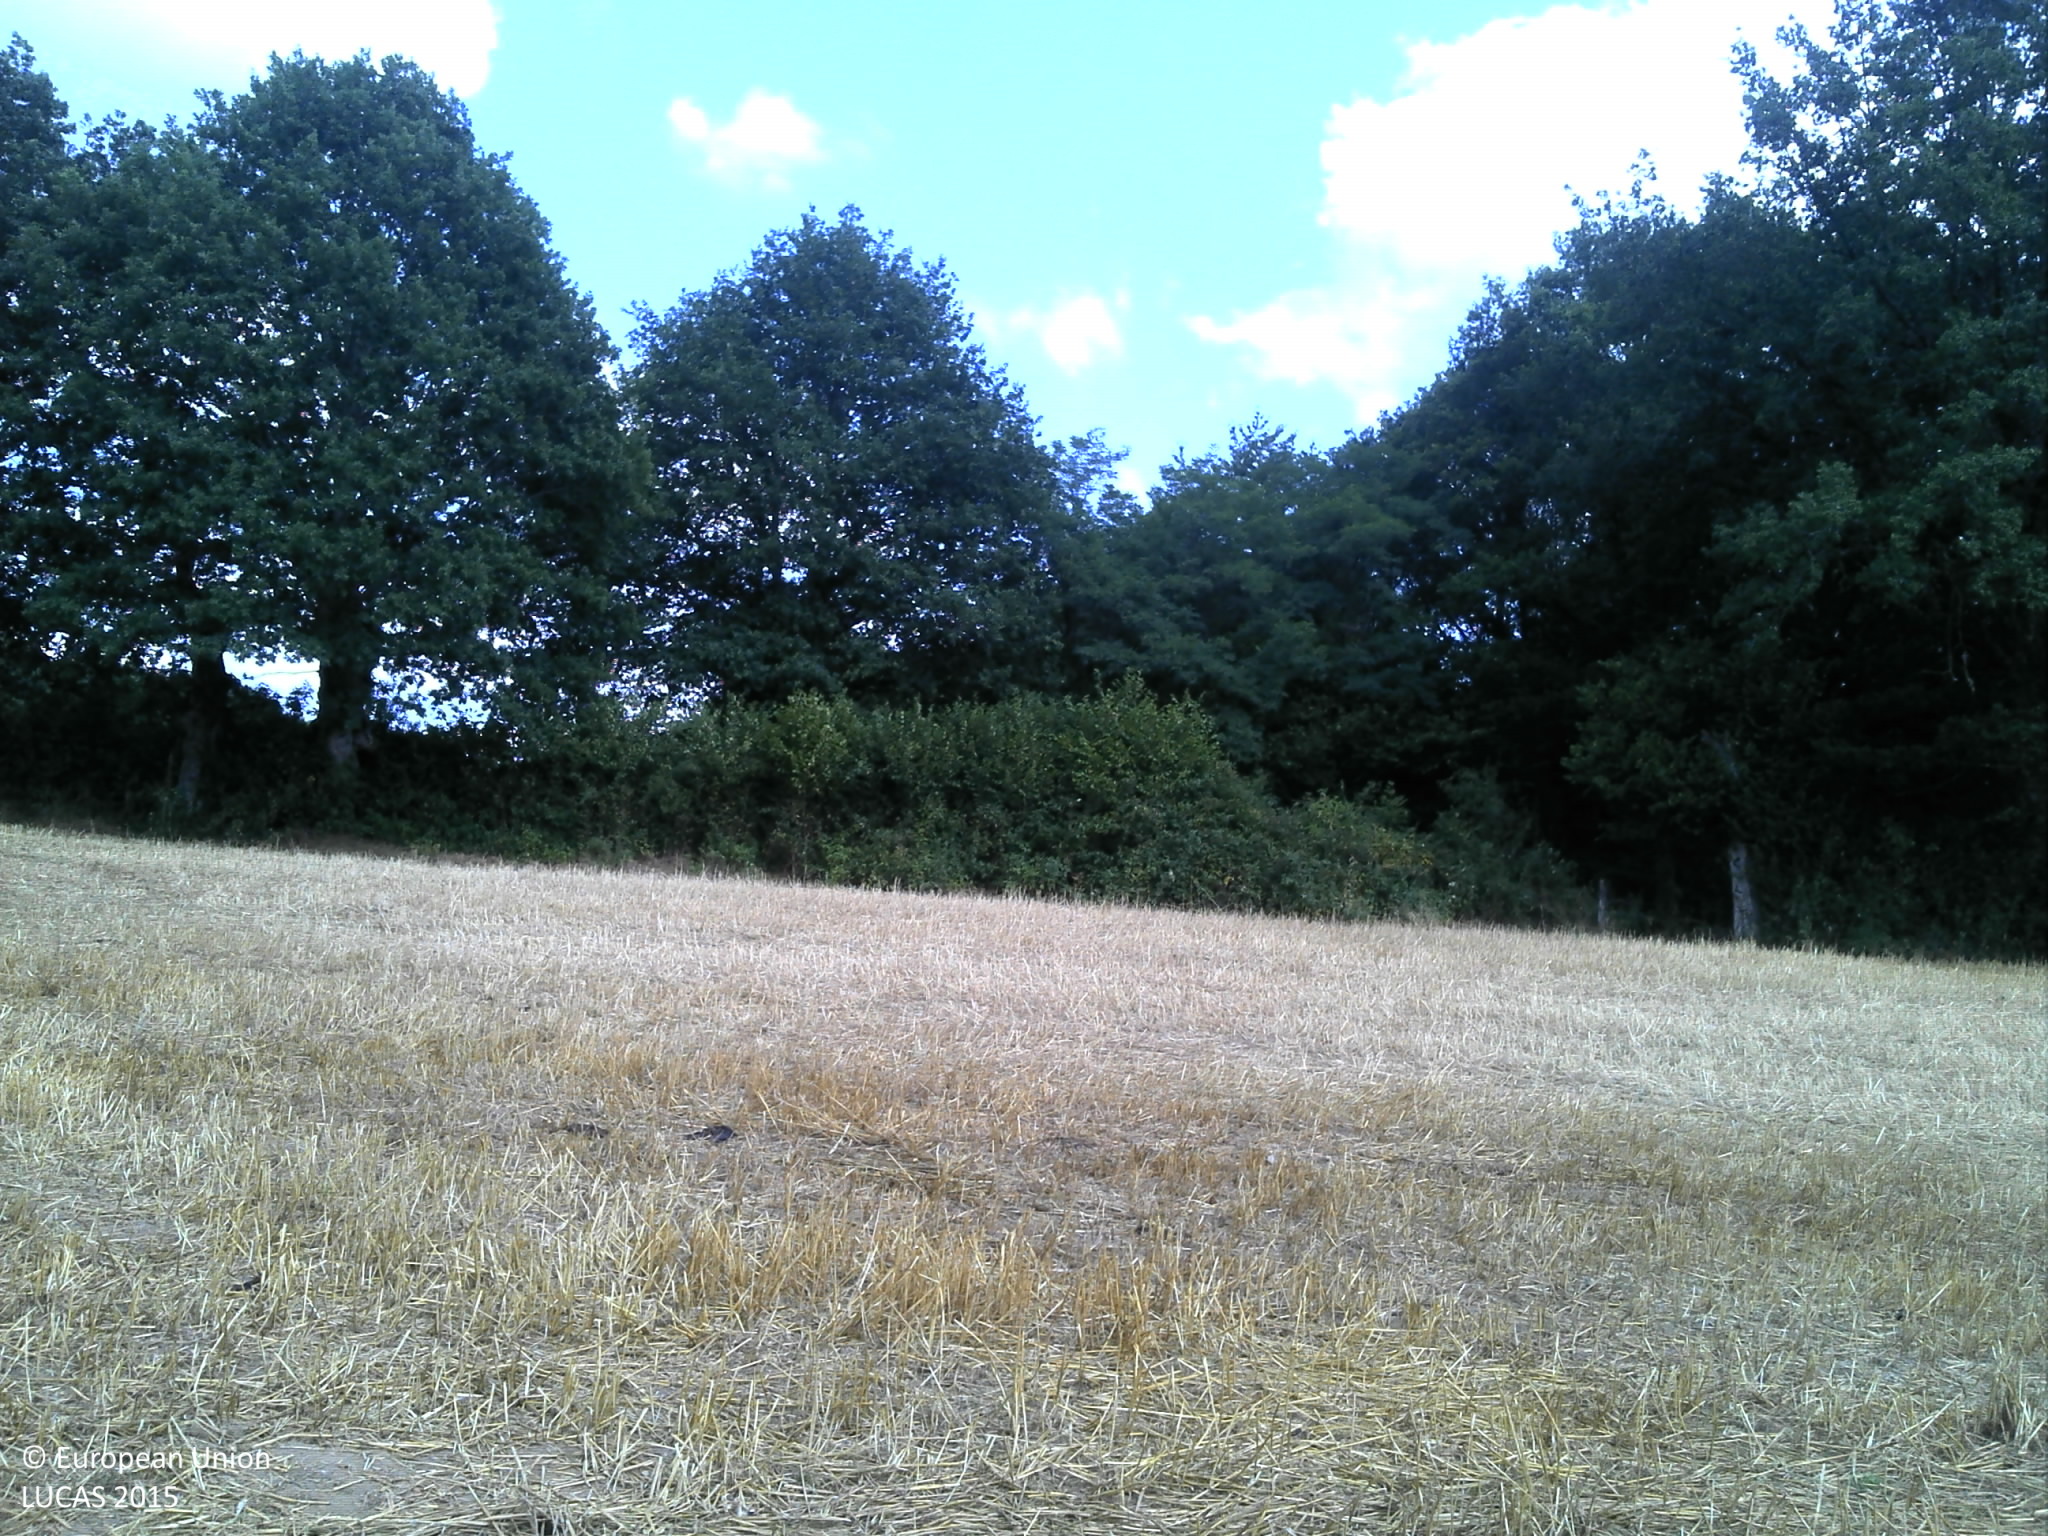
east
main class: Cropland
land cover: Common wheat
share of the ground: > 75 %
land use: Agriculture (excluding fallow land and kitchen gardens)
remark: Harvested field
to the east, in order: Common wheat; Managed hedges; Fences; Grass margins; Paved roads, cycling and walking lanes; Grass margins; Managed hedges; Fences; Lines of trees; Grassland without tree/shrub cover; Fences; Broadleaved woodland; Other mixed woodland; Fences; Grassland without tree/shrub cover
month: August
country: FR
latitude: 45.5202
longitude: 2.4063
